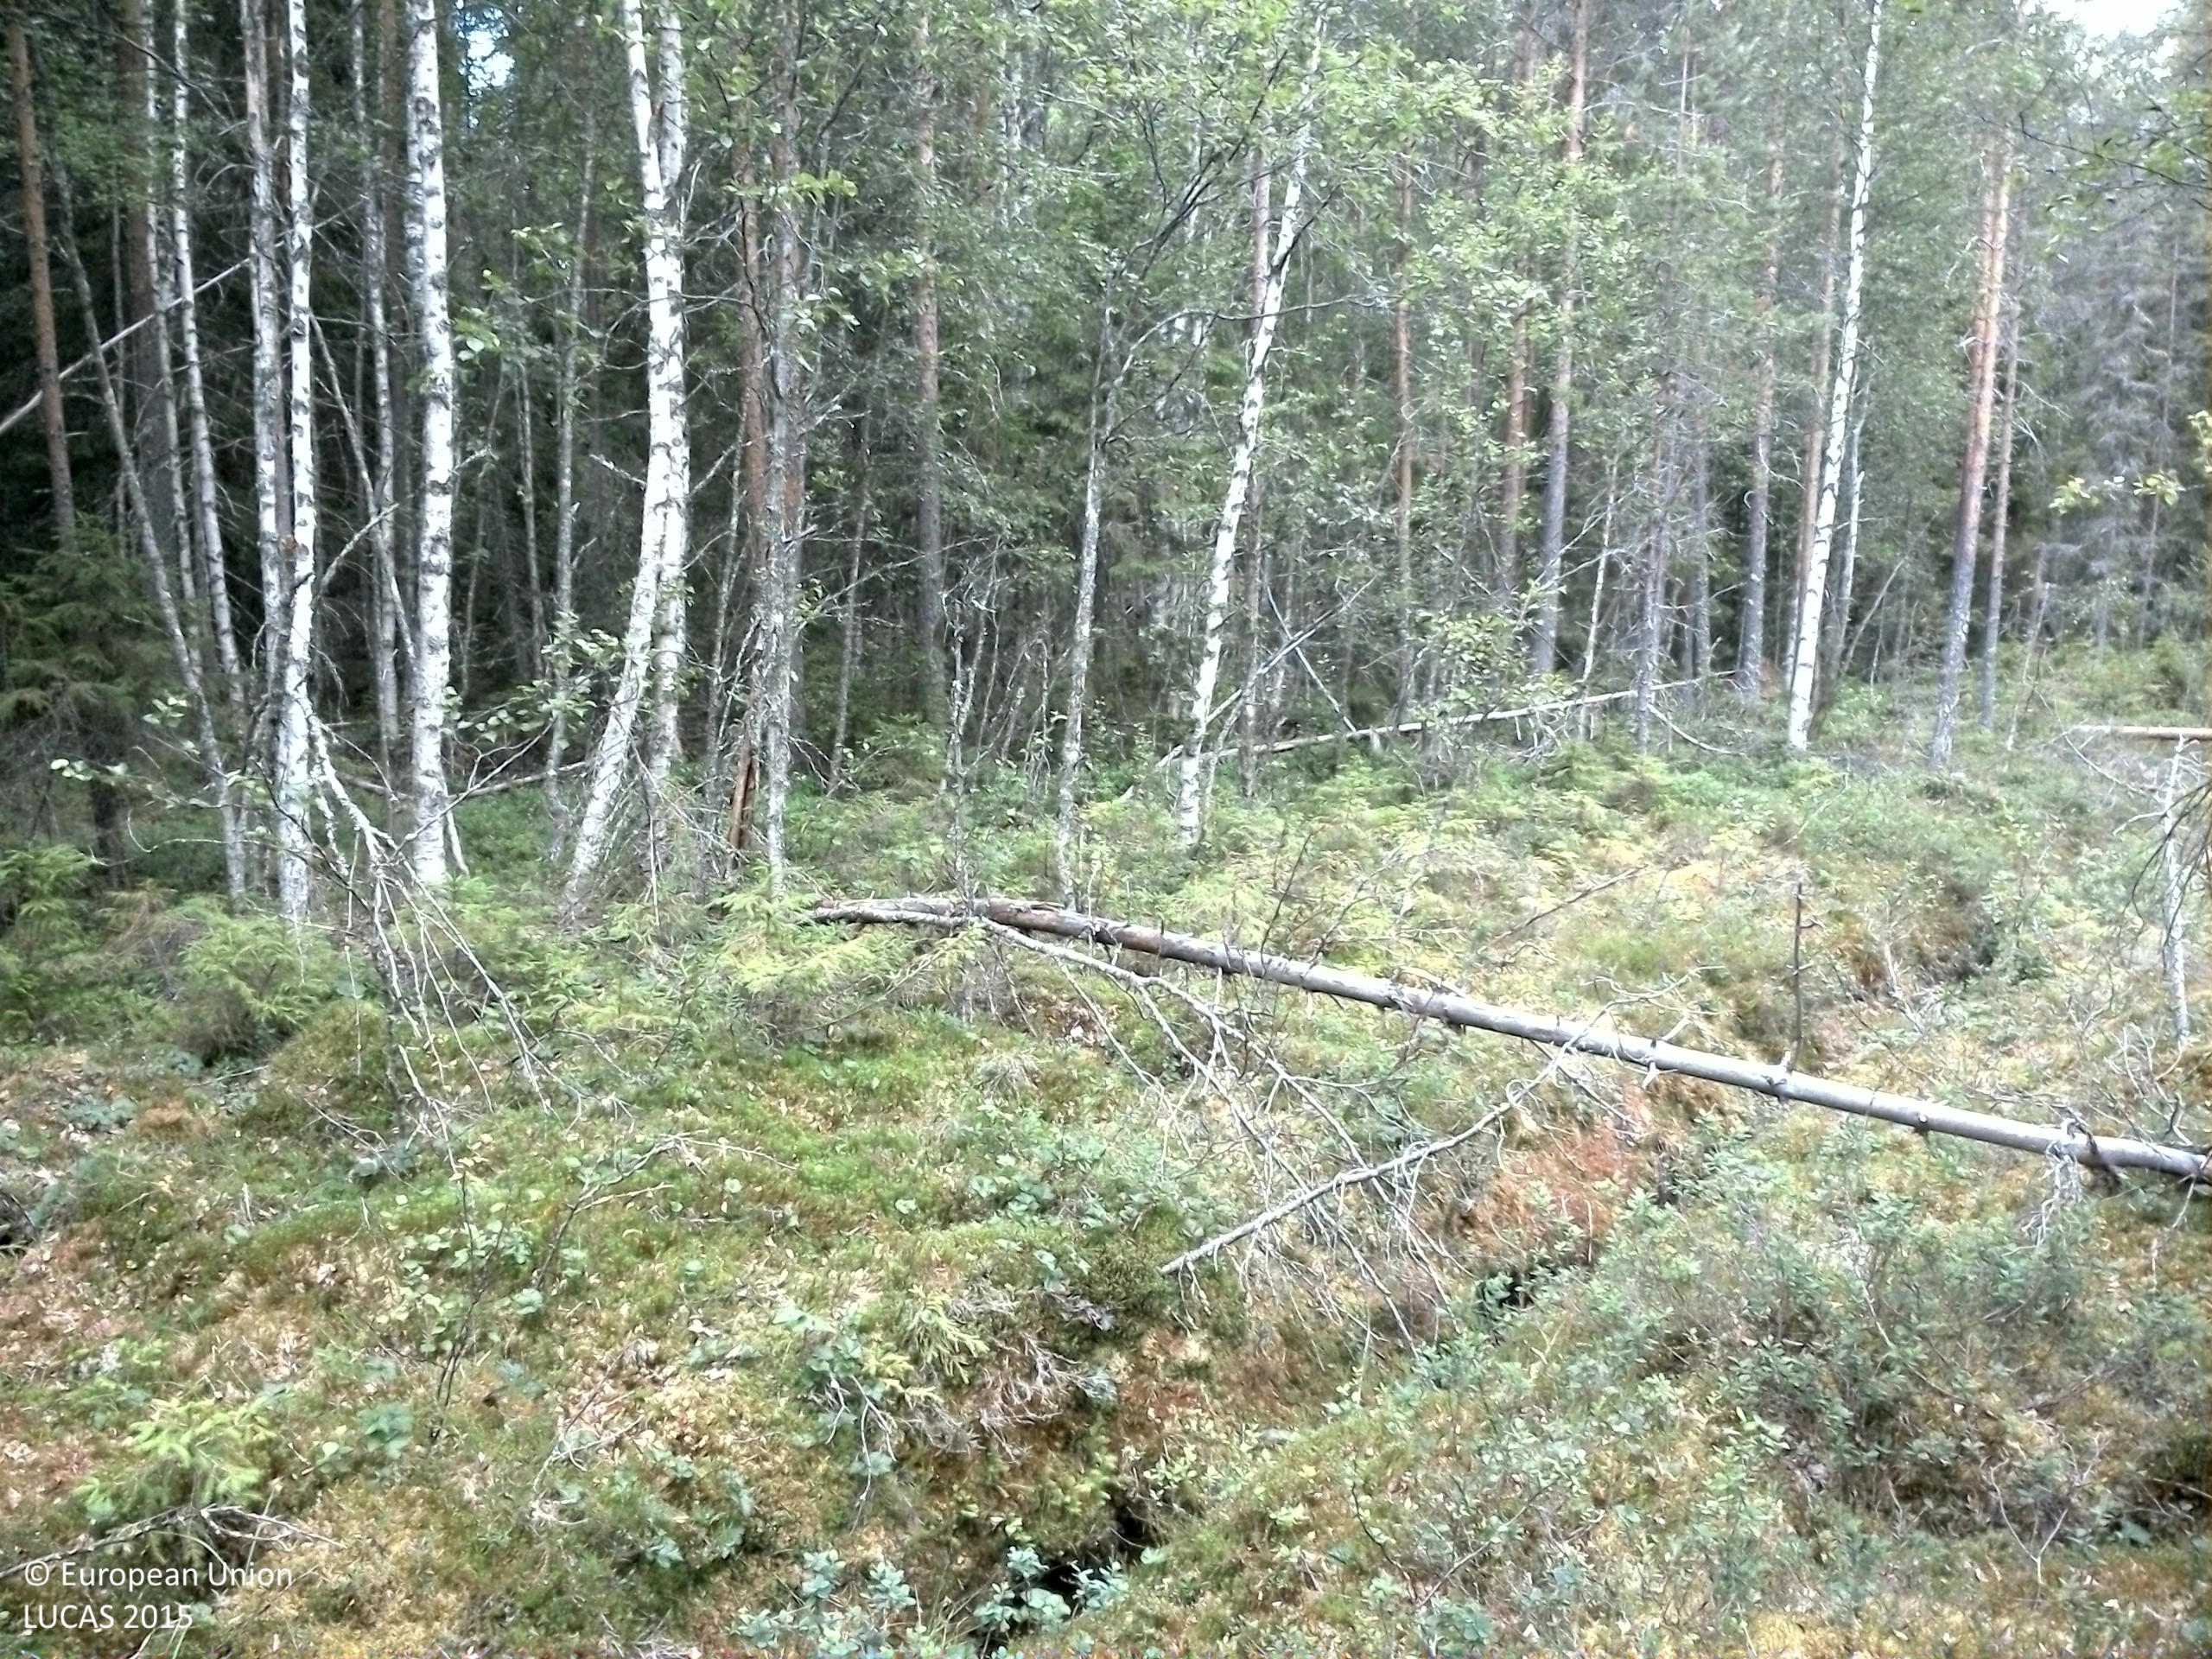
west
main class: Woodland
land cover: Pine dominated mixed woodland
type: boreal forest
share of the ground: 50 - 75 %
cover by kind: coniferous forest trees 35 %, shrubs 25 %, broadleaved forest trees 20 %, lichens and mosses 15 %, herbaceous plants 5 %
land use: Forestry
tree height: > 5 m
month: August
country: SE
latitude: 63.5919
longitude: 16.5631
